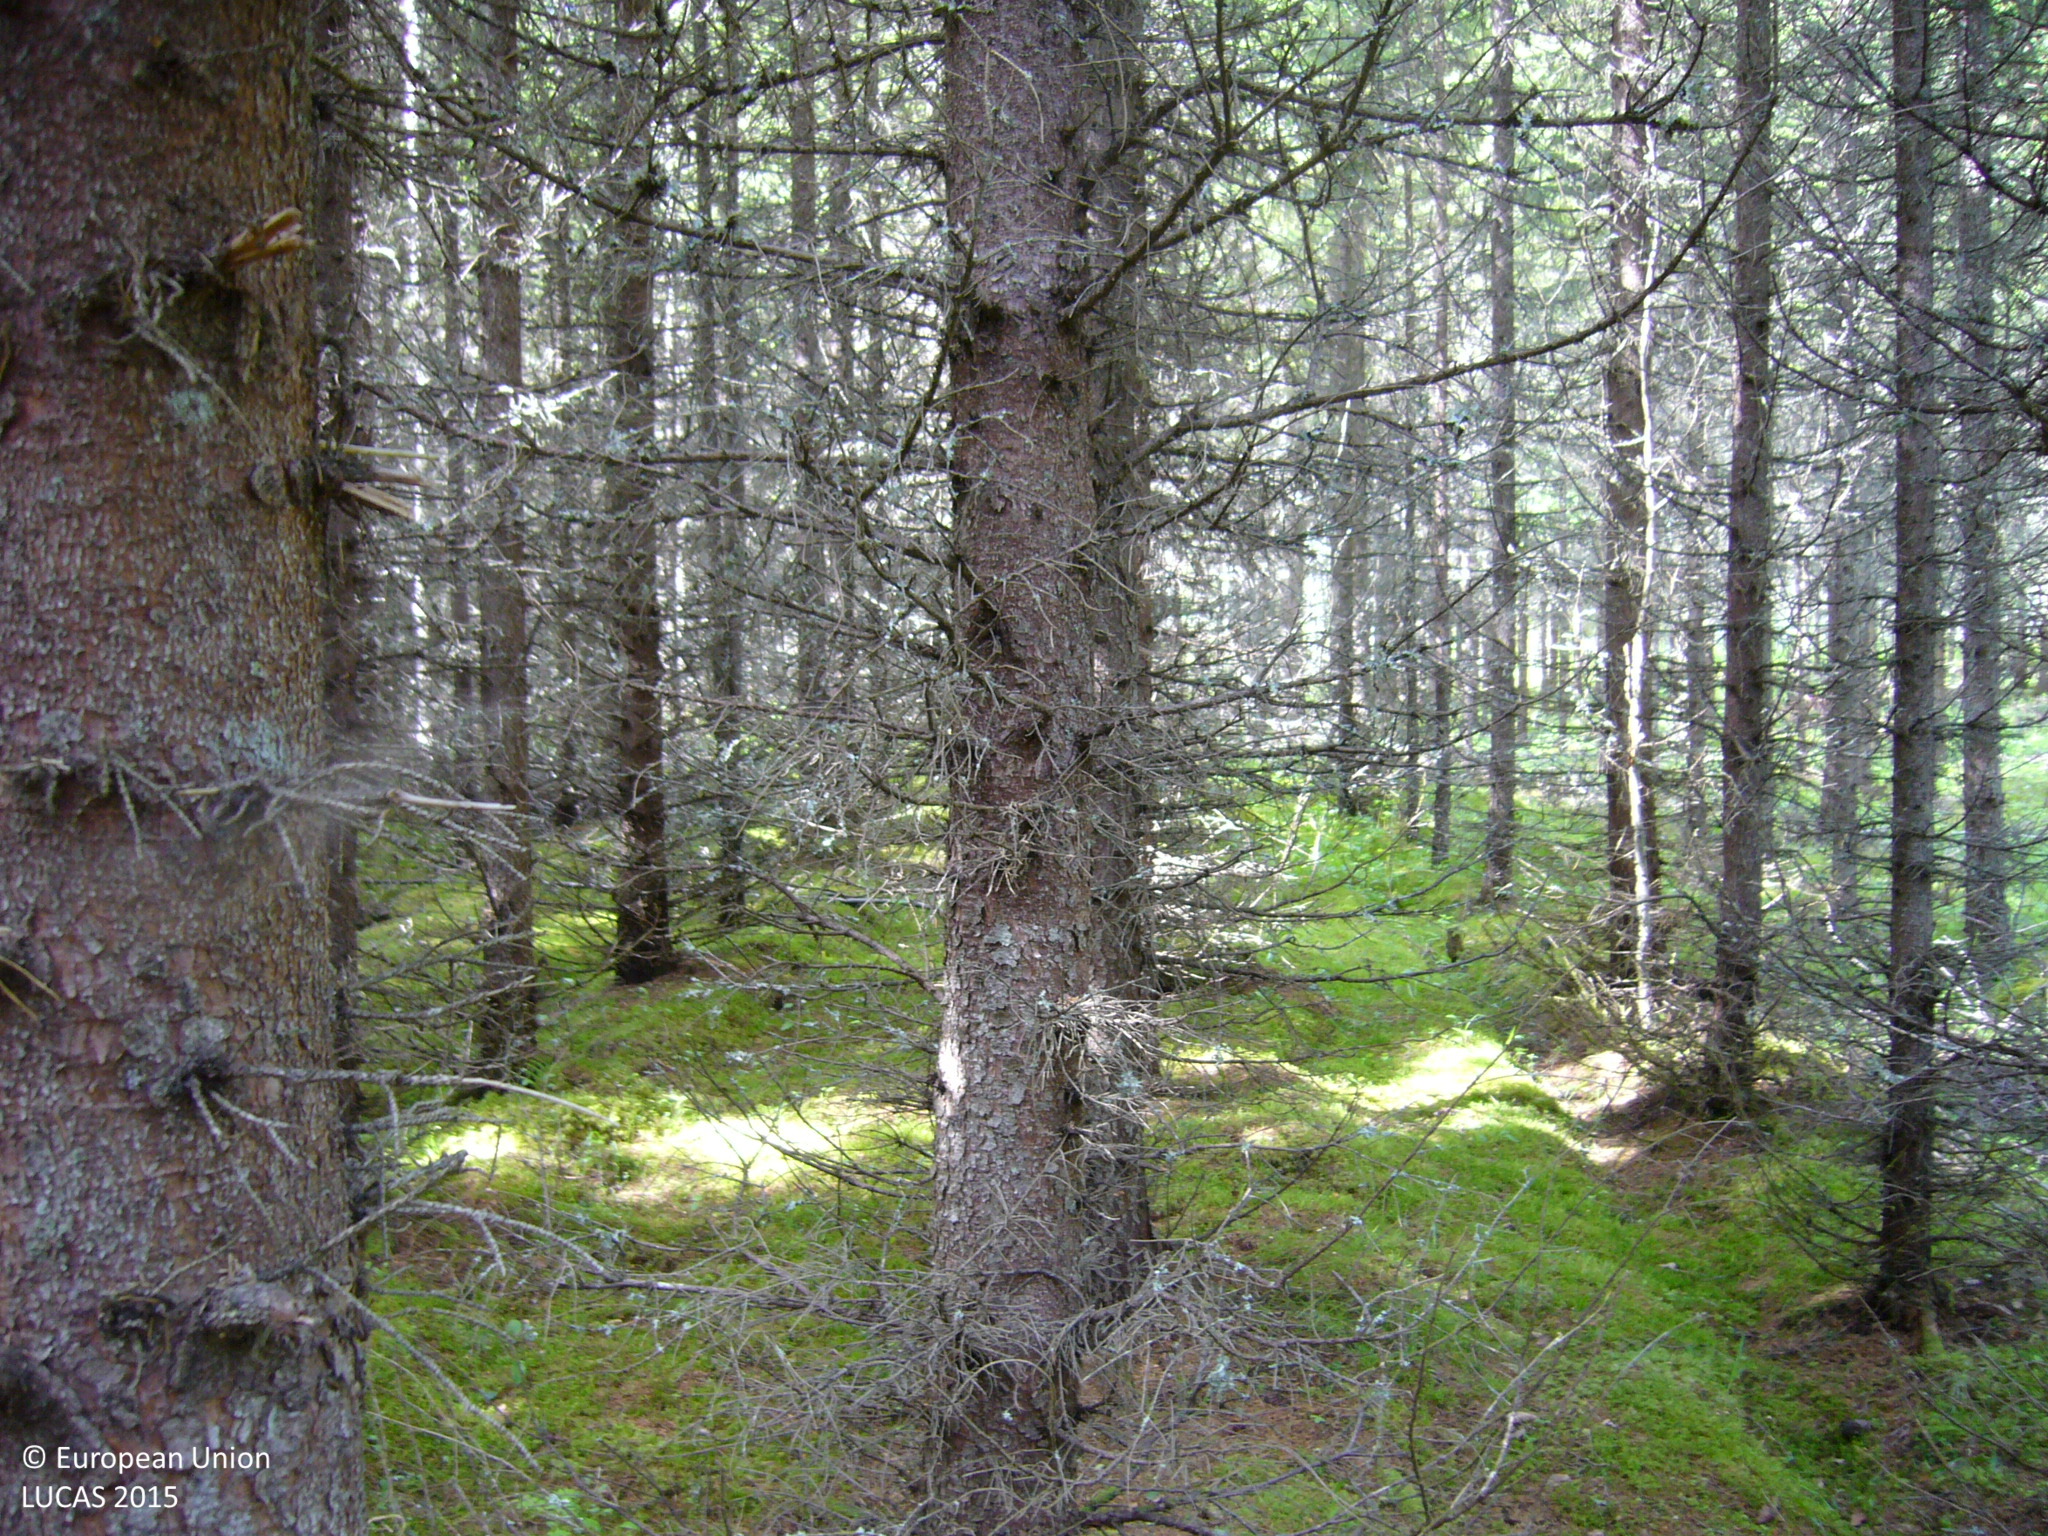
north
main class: Woodland
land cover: Spruce dominated coniferous woodland
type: boreal forest
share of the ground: > 75 %
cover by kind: coniferous forest trees 85 %, shrubs 10 %, broadleaved forest trees 5 %
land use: Forestry
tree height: > 5 m
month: July
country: FI
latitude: 63.5007
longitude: 26.2096
